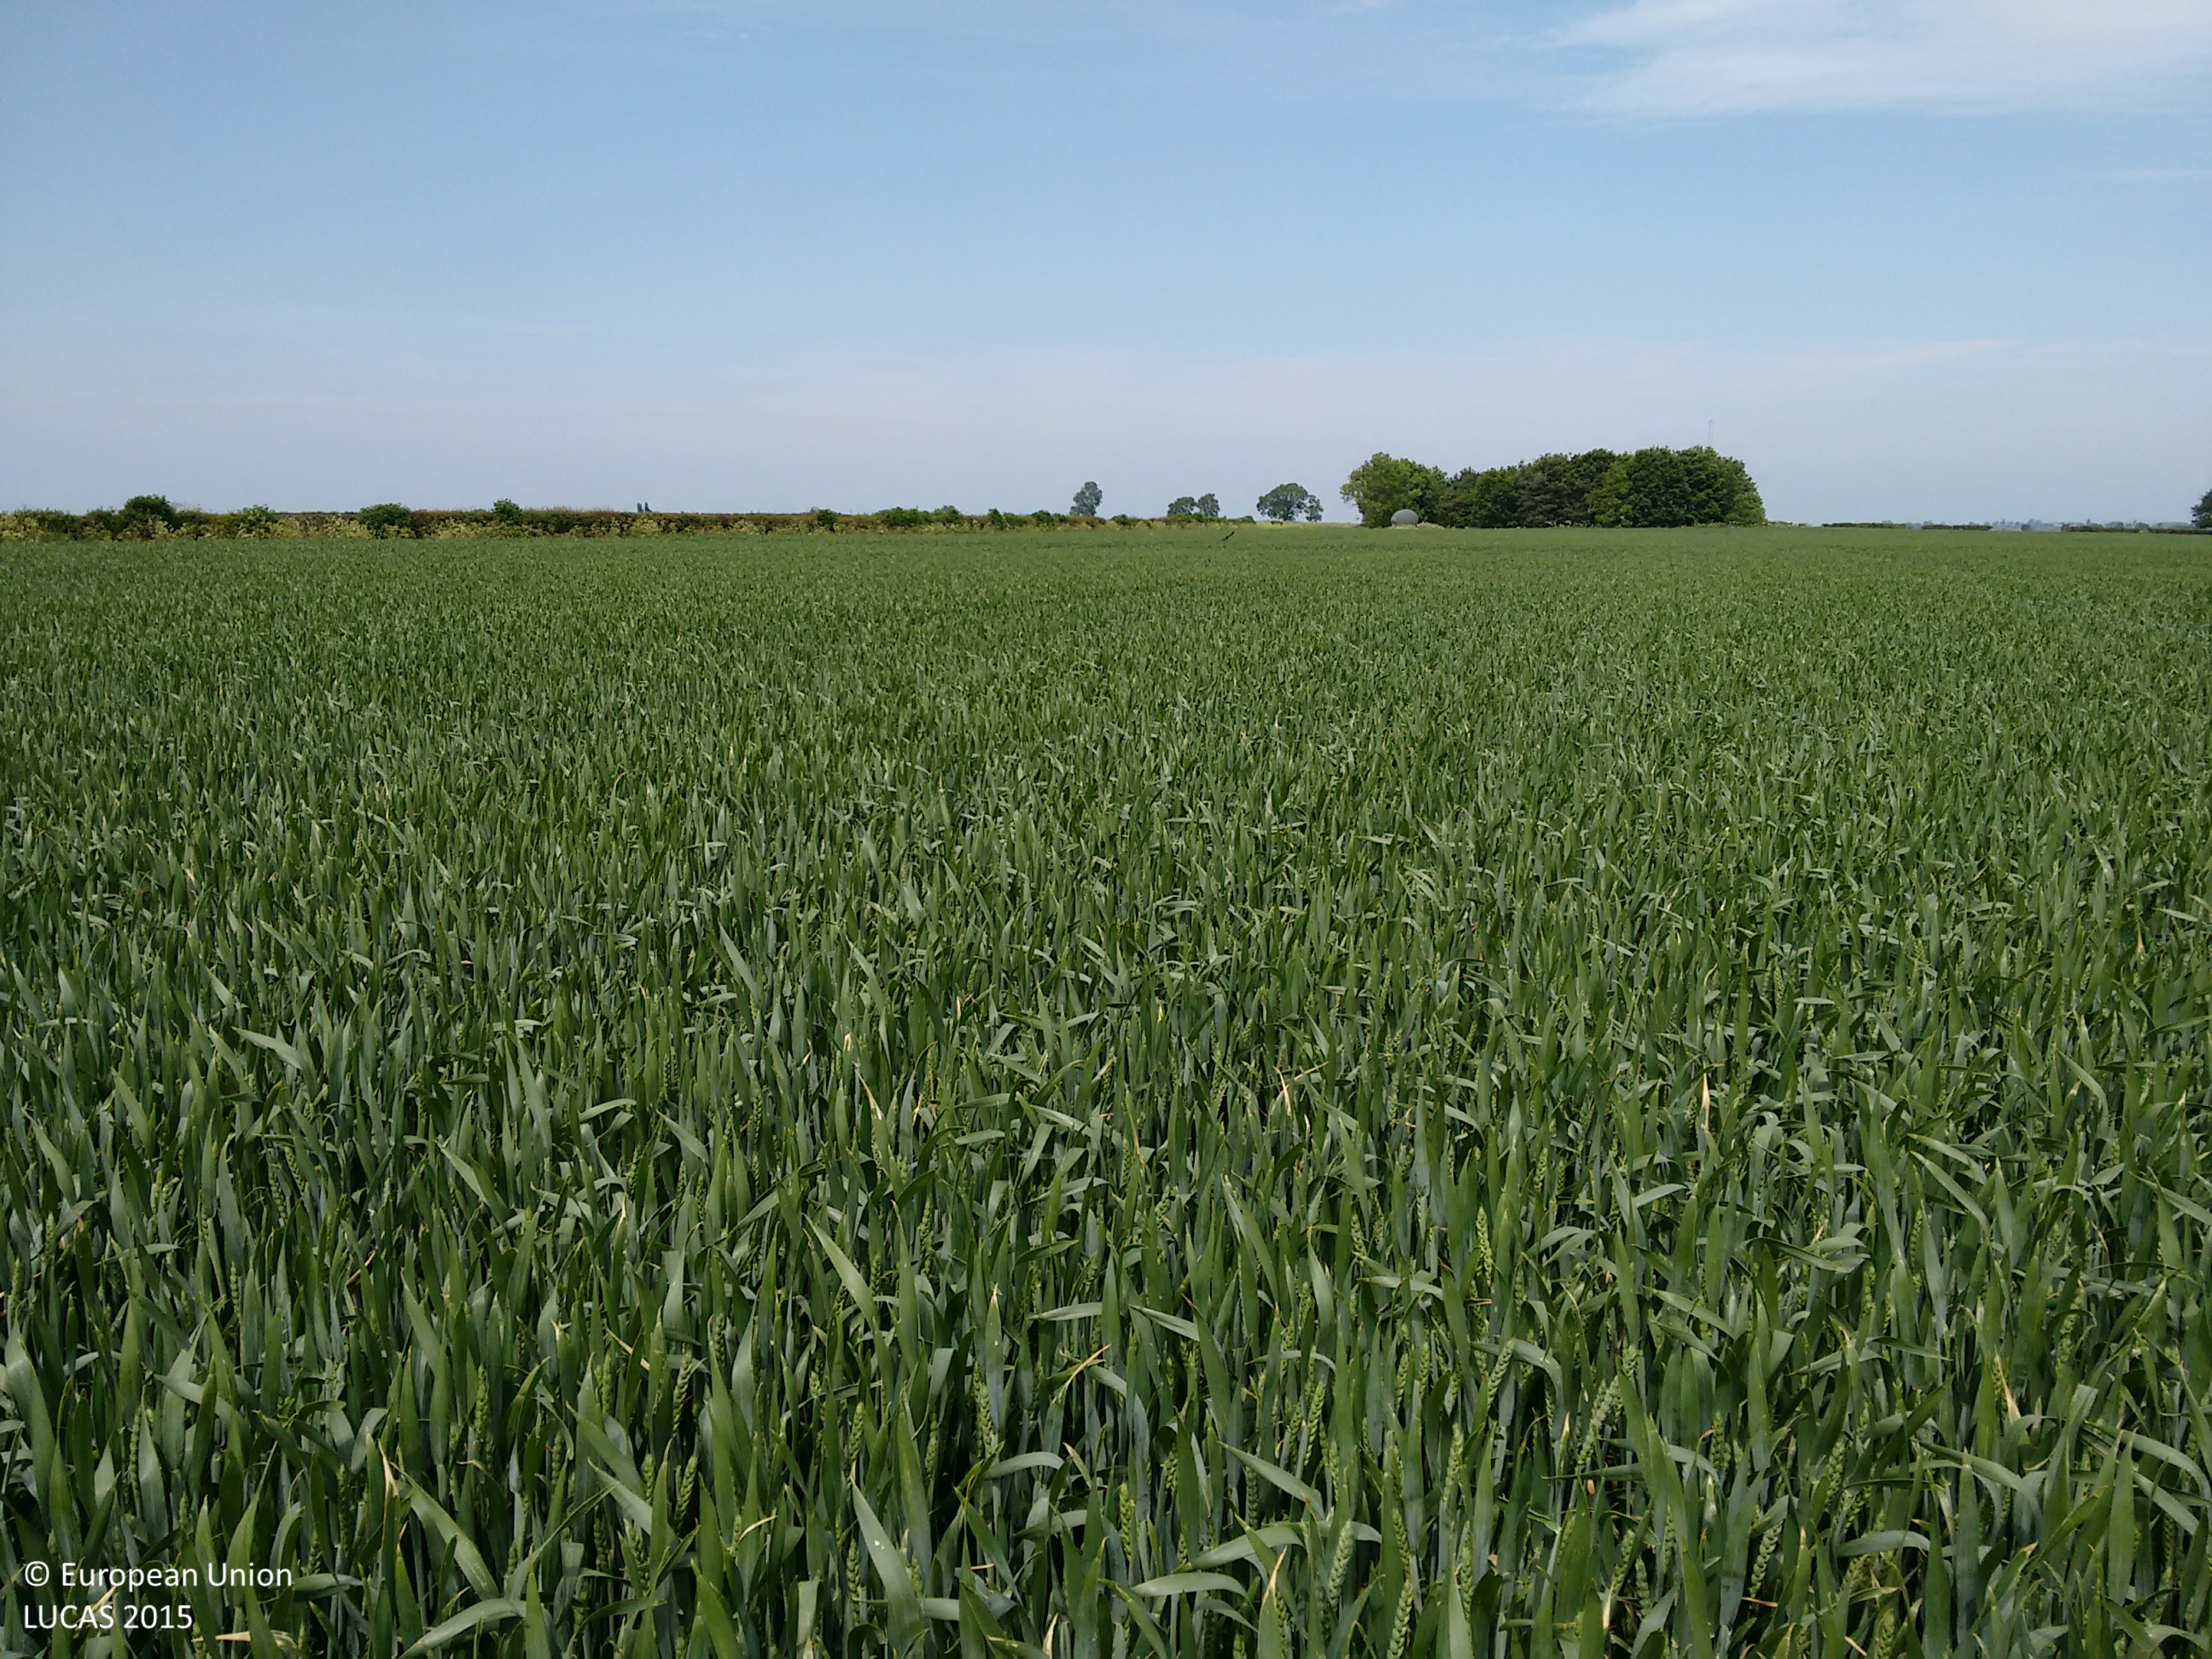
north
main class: Cropland
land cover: Common wheat
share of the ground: > 75 %
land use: Agriculture (excluding fallow land and kitchen gardens)
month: June
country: GB
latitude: 52.9870
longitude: -0.6304
